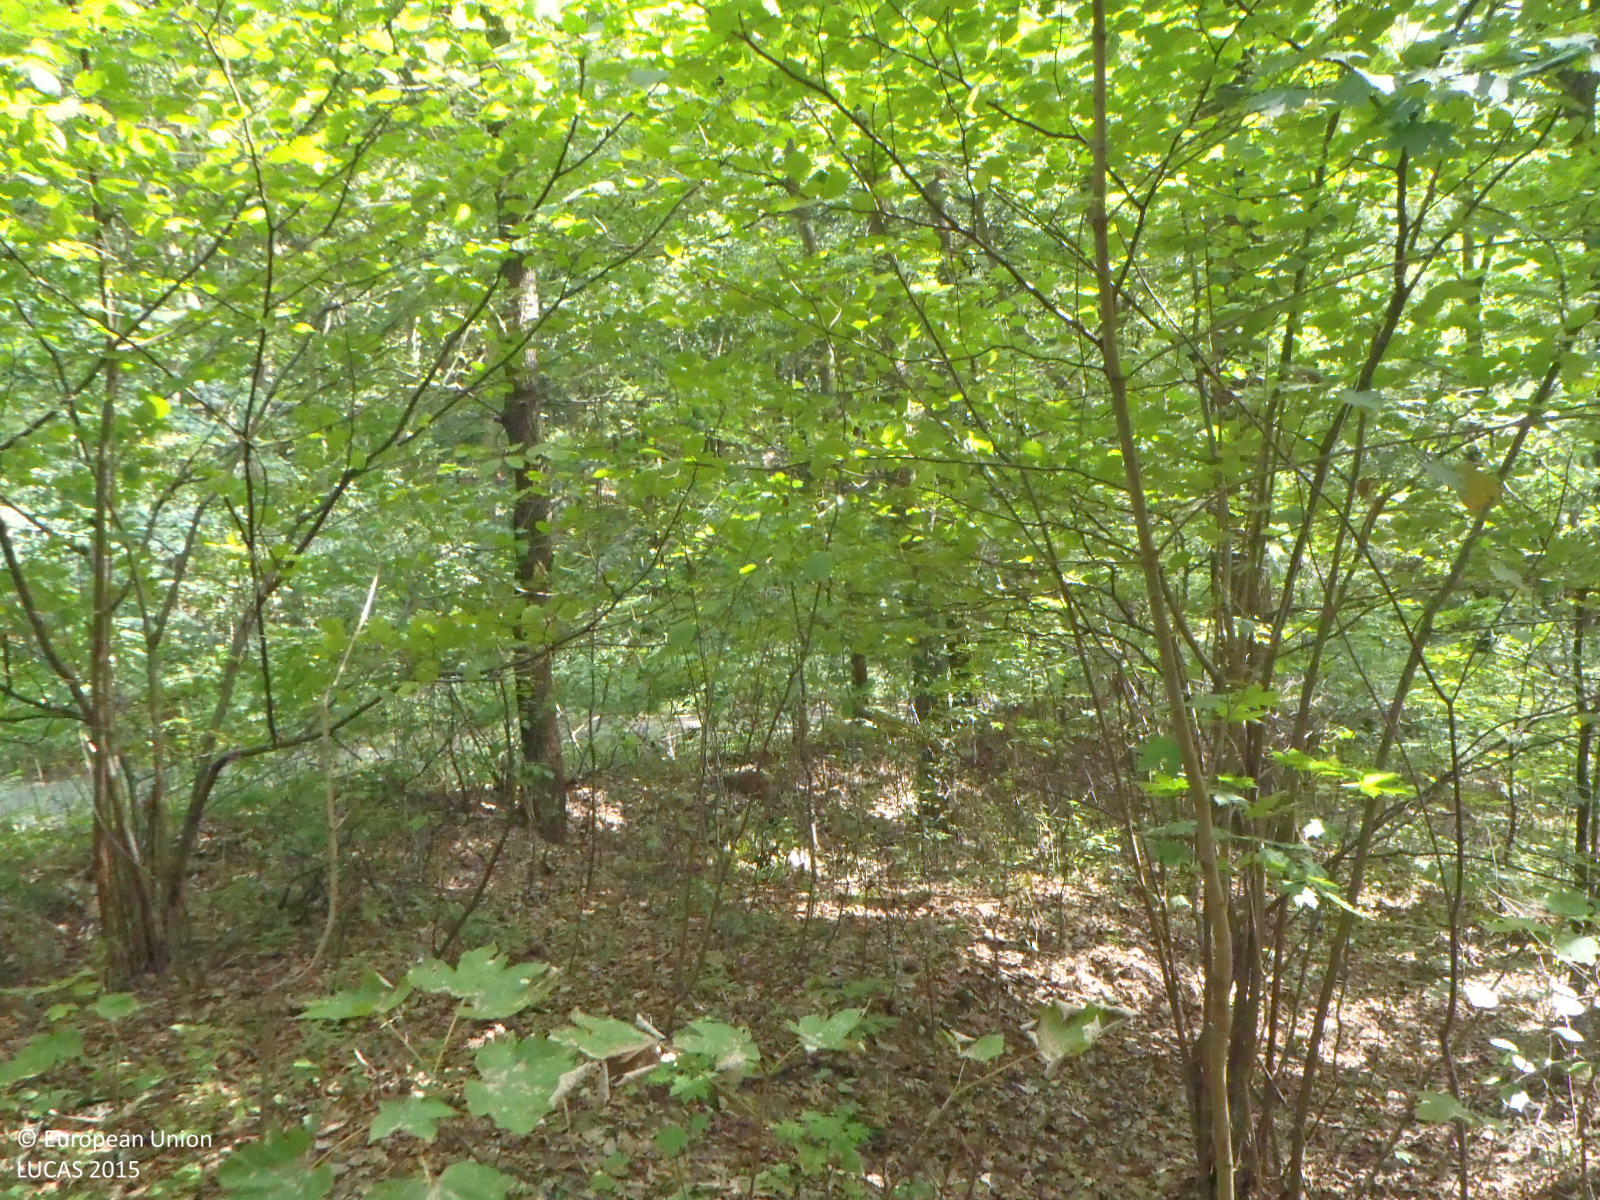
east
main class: Woodland
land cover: Spruce dominated mixed woodland
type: hemiboreal forest and nemoral coniferous forest and mixed broadleaved-coniferous forest
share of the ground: > 75 %
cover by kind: broadleaved forest trees 70 %, coniferous forest trees 30 %
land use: Forestry
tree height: > 5 m
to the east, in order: Spruce dominated mixed woodland; Ditches and canals; Groves; Paved roads, cycling and walking lanes; Broadleaved woodland; Rivers and streams; Broadleaved woodland; Ditches and canals; Broadleaved woodland; Pine dominated mixed woodland; Broadleaved woodland; Other mixed woodland
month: September
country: CZ
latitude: 50.6938
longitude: 13.8939
